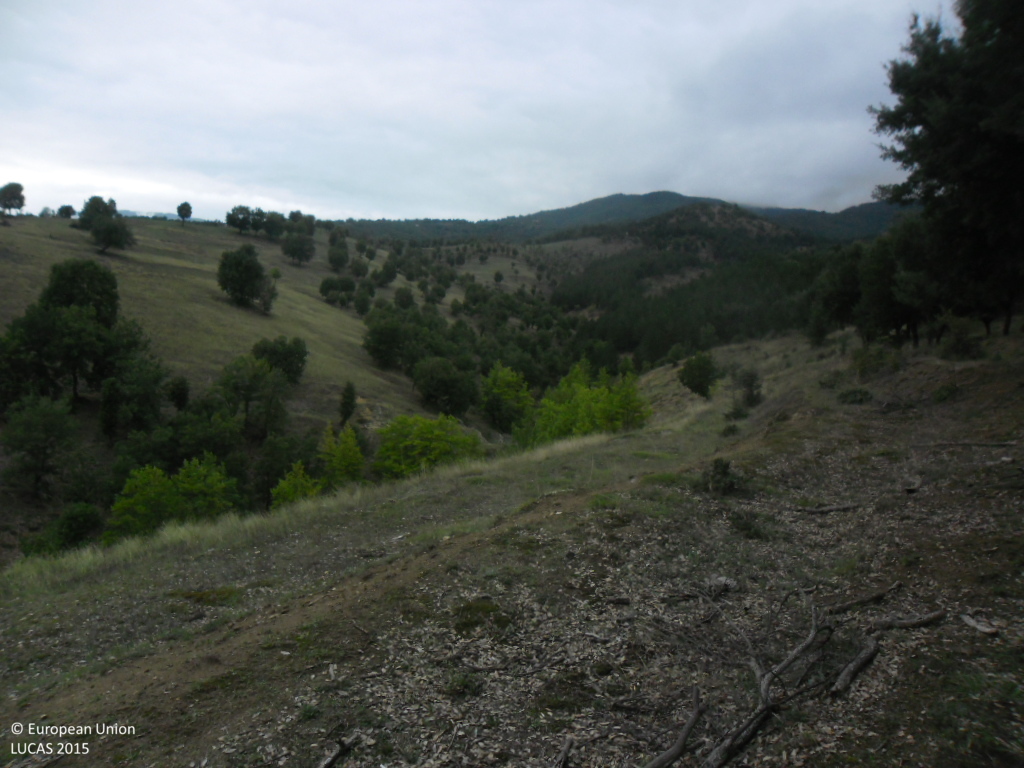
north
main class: Grassland
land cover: Grassland with sparse tree/shrub cover
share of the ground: > 75 %
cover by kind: herbaceous plants 90 %, broadleaved forest trees 5 %, shrubs 5 %
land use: Agriculture (excluding fallow land and kitchen gardens)
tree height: < 5 m
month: September
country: BG
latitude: 41.4223
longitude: 23.0474
